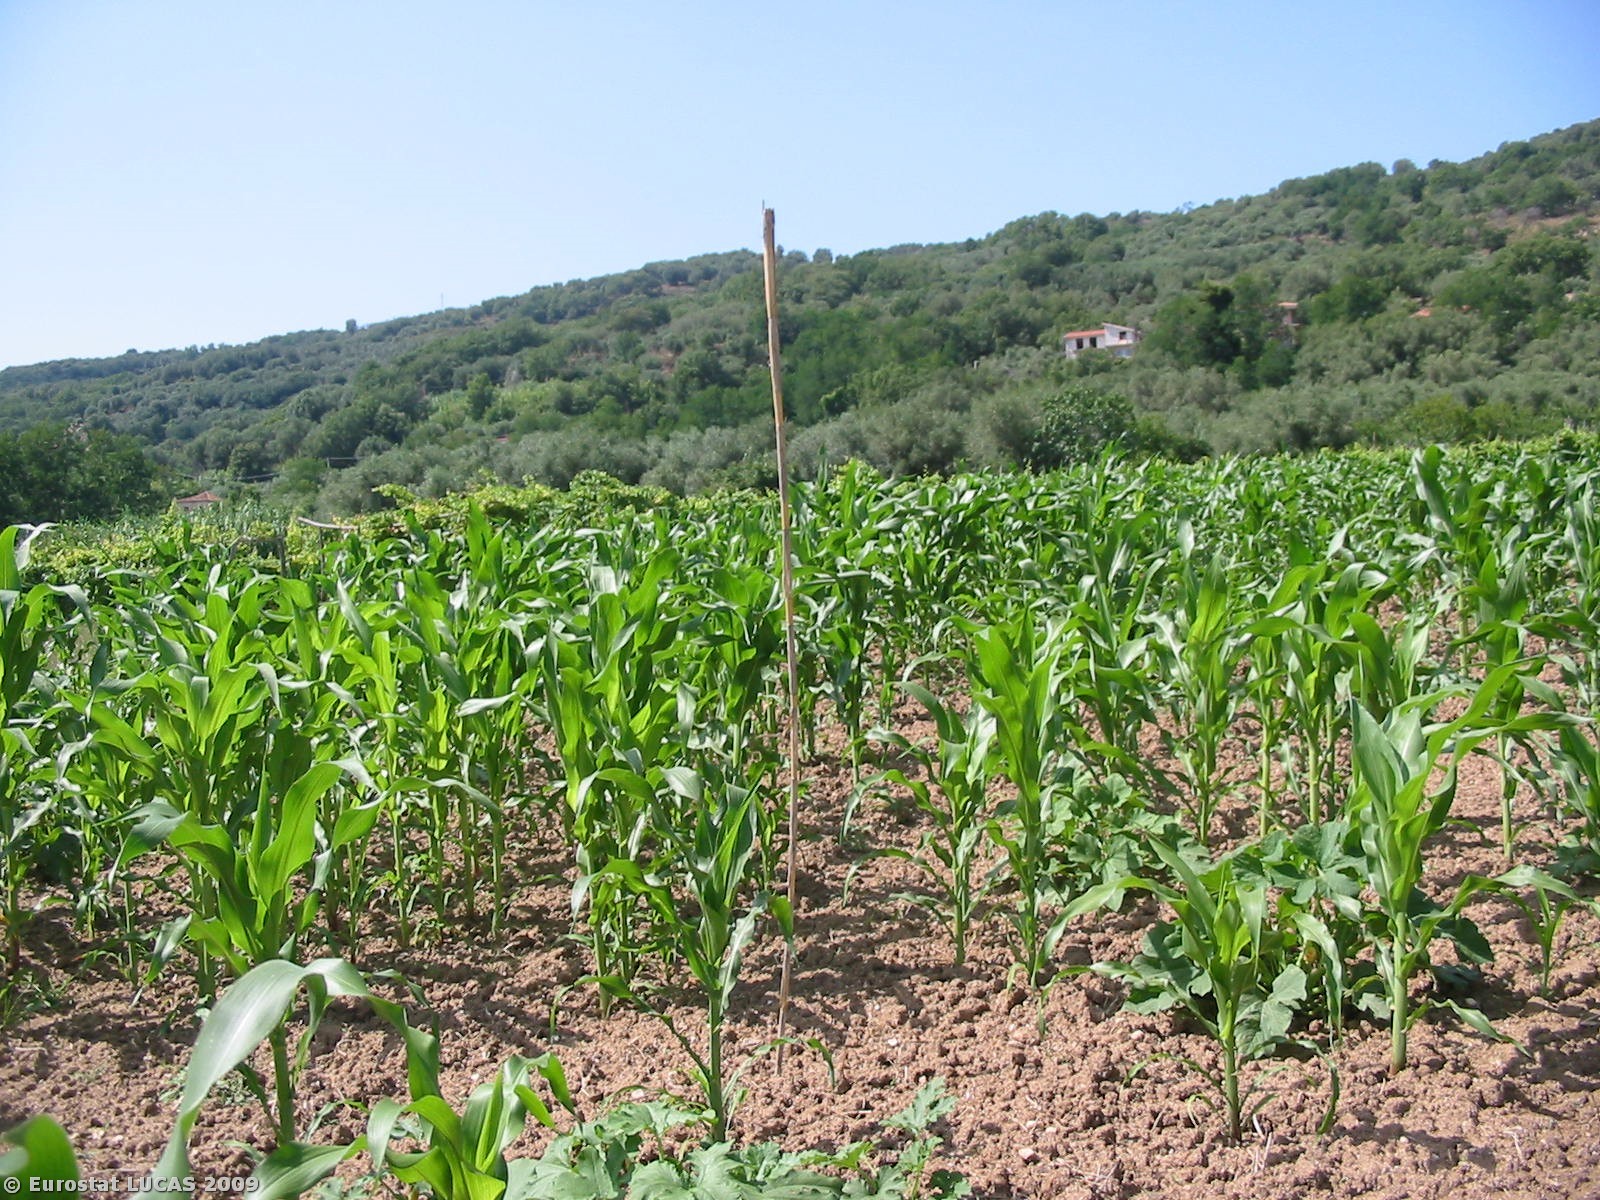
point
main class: Cropland
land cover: Maize
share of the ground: 50 - 75 %
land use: Agriculture (excluding fallow land and kitchen gardens)
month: July
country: IT
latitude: 38.5797
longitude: 15.9465
